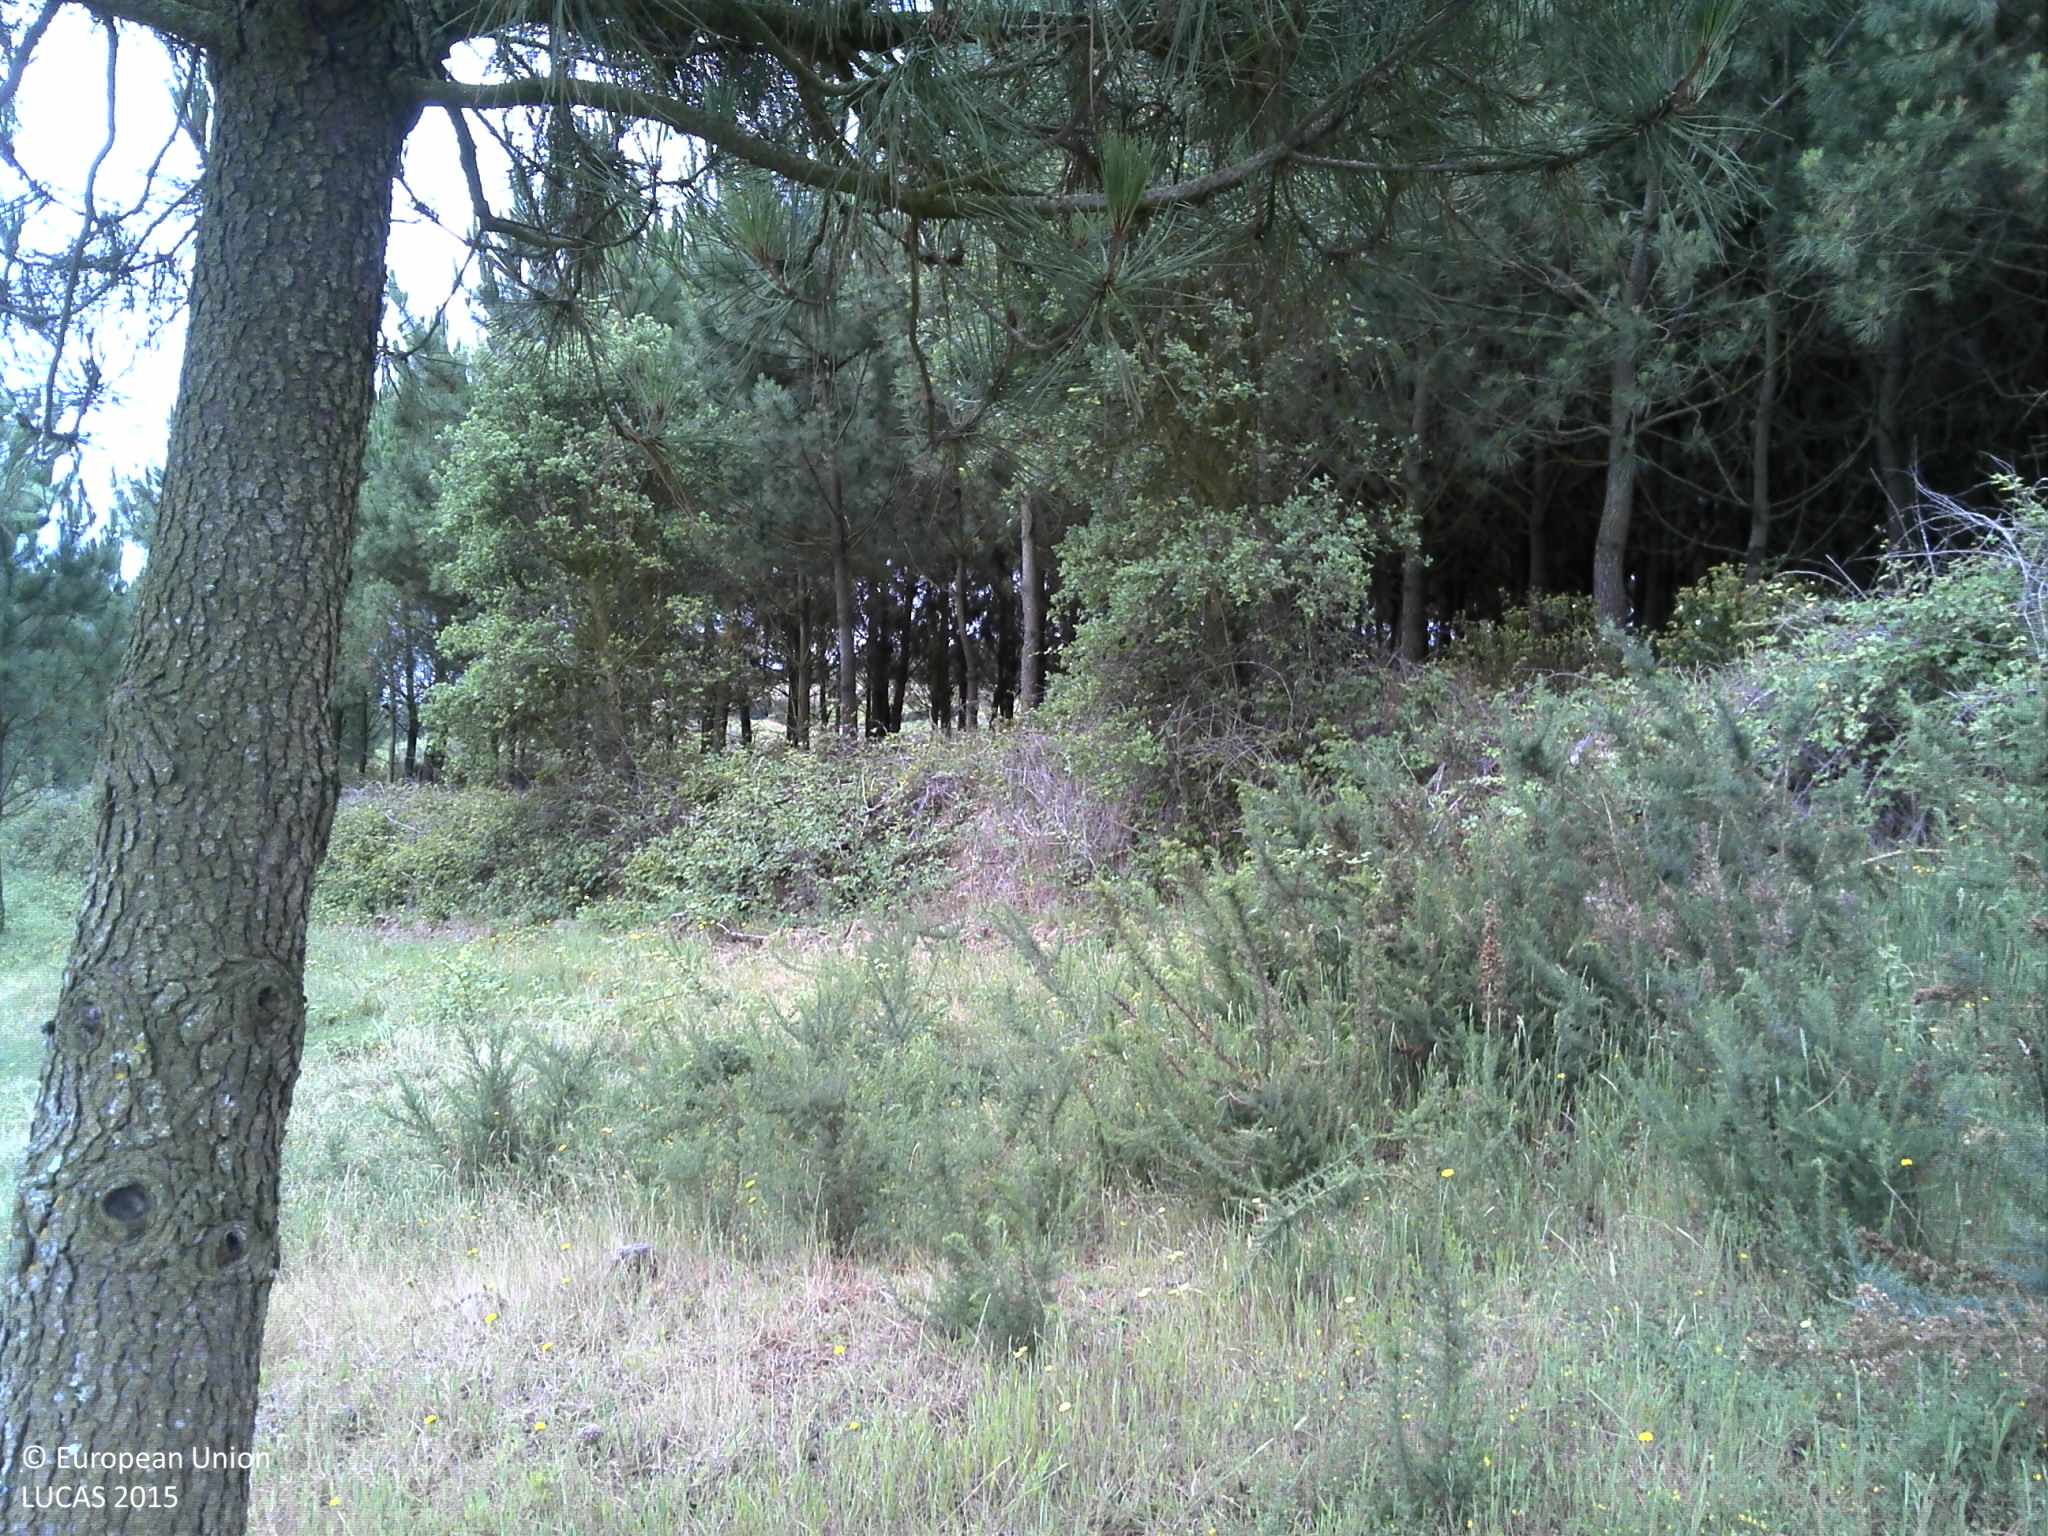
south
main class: Woodland
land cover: Pine dominated coniferous woodland
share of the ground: 10 - 25 %
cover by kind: herbaceous plants 60 %, shrubs 20 %, coniferous forest trees 10 %, unconsolidated bare surface 10 %
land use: Forestry
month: June
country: PT
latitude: 39.2418
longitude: -9.1930
